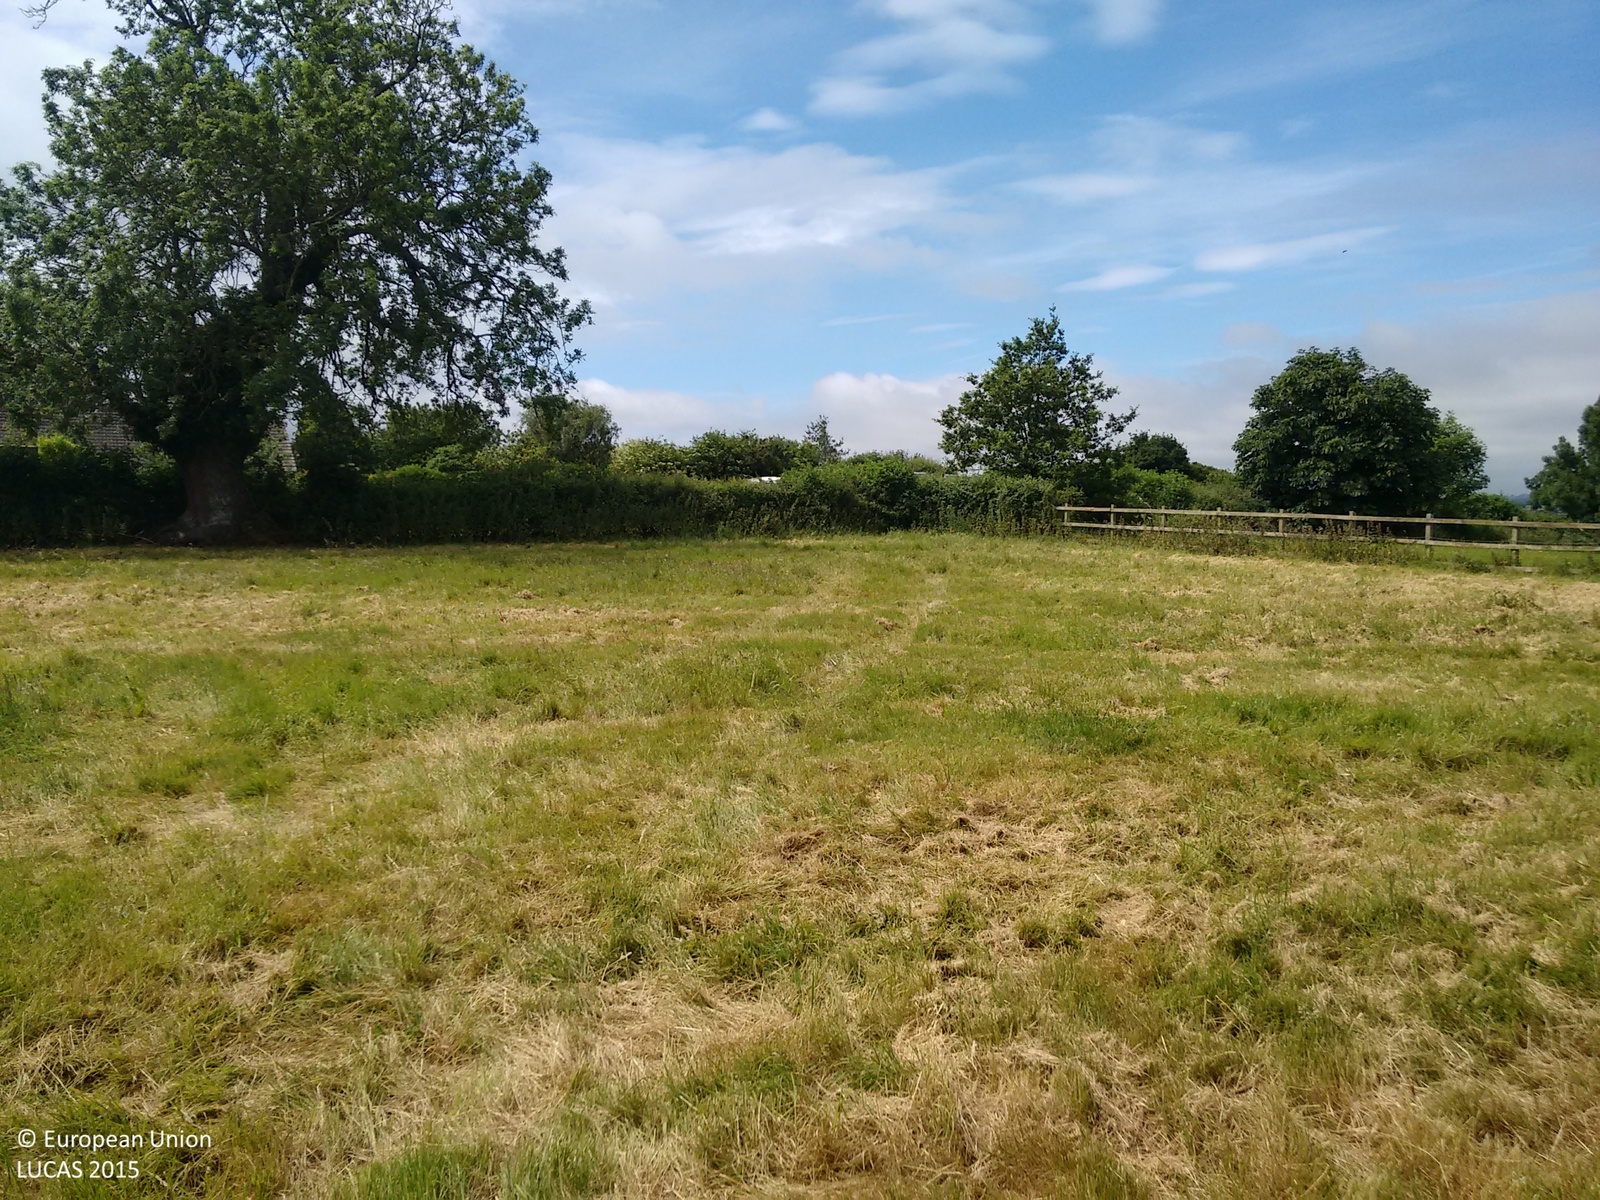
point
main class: Grassland
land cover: Grassland without tree/shrub cover
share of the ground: > 75 %
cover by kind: herbaceous plants 100 %
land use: Agriculture (excluding fallow land and kitchen gardens)
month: June
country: GB
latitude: 51.2217
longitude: -2.3344
